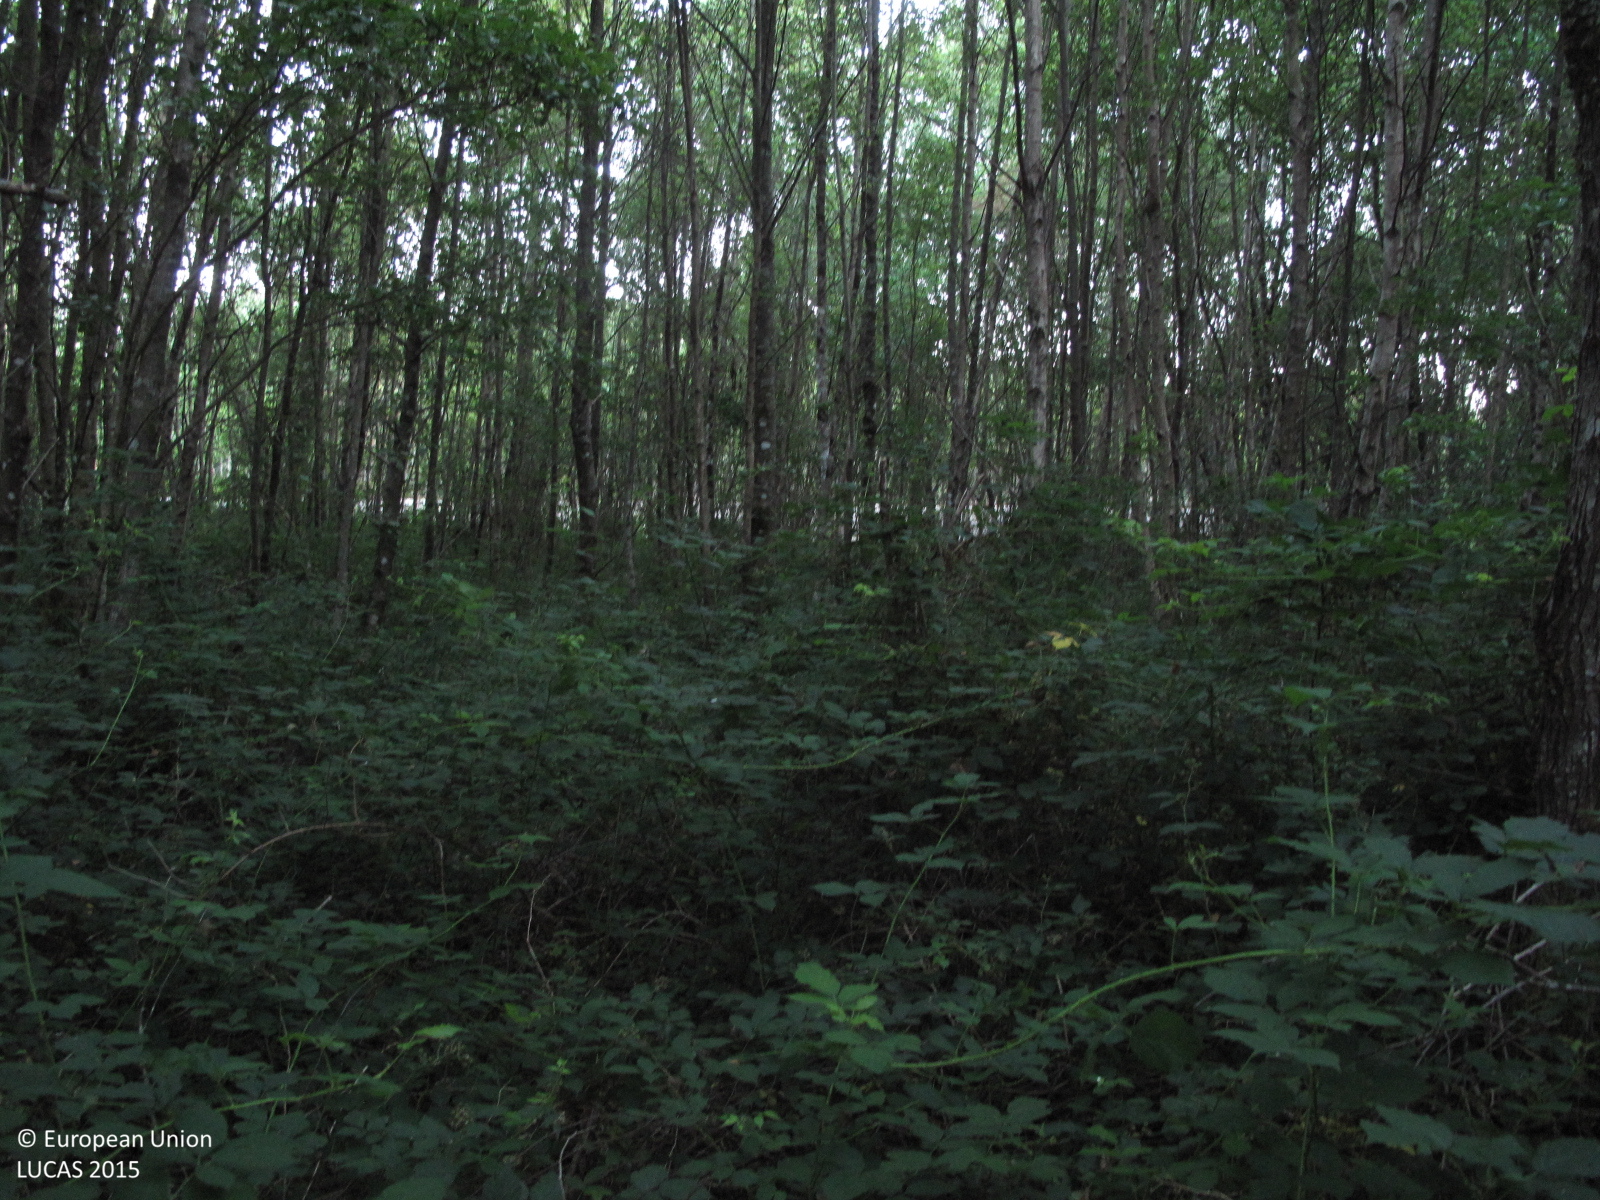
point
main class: Woodland
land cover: Broadleaved woodland
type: acidophilous oak and oak-birch forest
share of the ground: > 75 %
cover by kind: broadleaved forest trees 90 %, shrubs 5 %, herbaceous plants 5 %
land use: Semi-natural and natural areas not in use
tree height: > 5 m
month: July
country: ES
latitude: 43.1812
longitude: -7.9166
